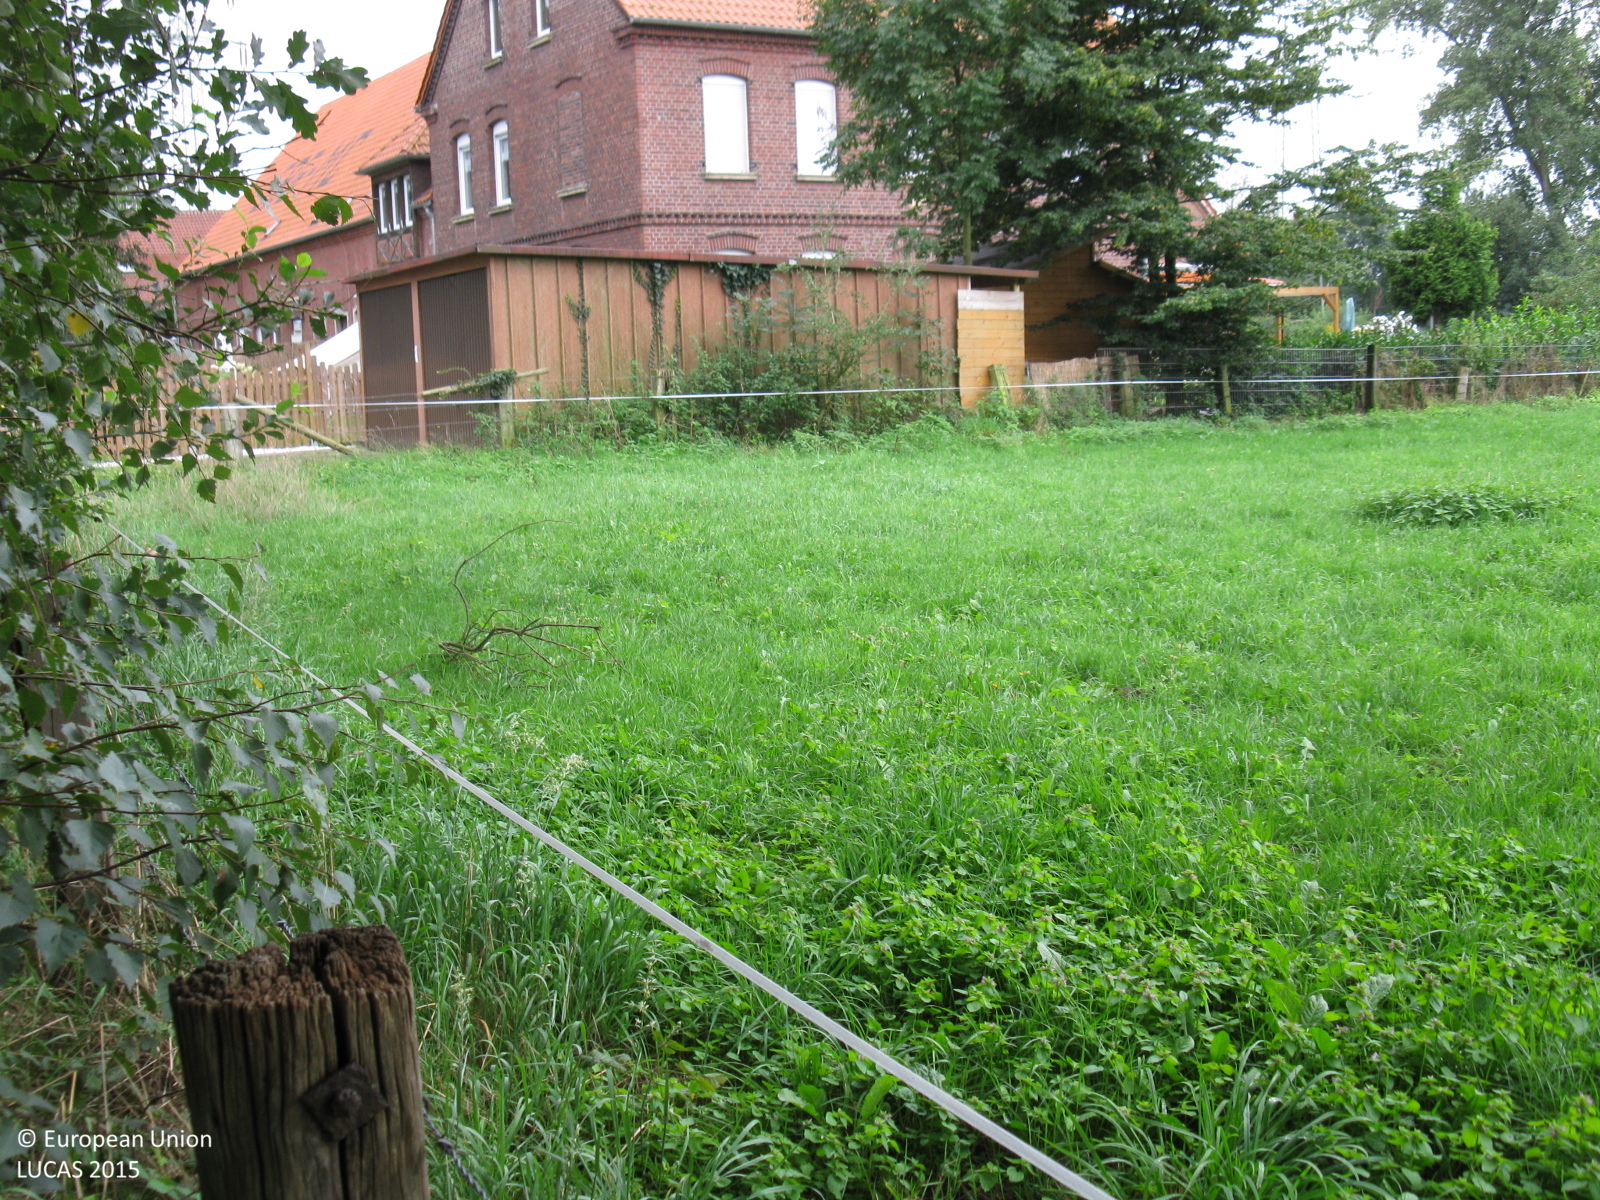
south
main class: Grassland
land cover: Grassland without tree/shrub cover
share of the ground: > 75 %
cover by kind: herbaceous plants 100 %
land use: Agriculture (excluding fallow land and kitchen gardens)
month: August
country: DE
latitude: 51.7101
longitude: 7.0043
